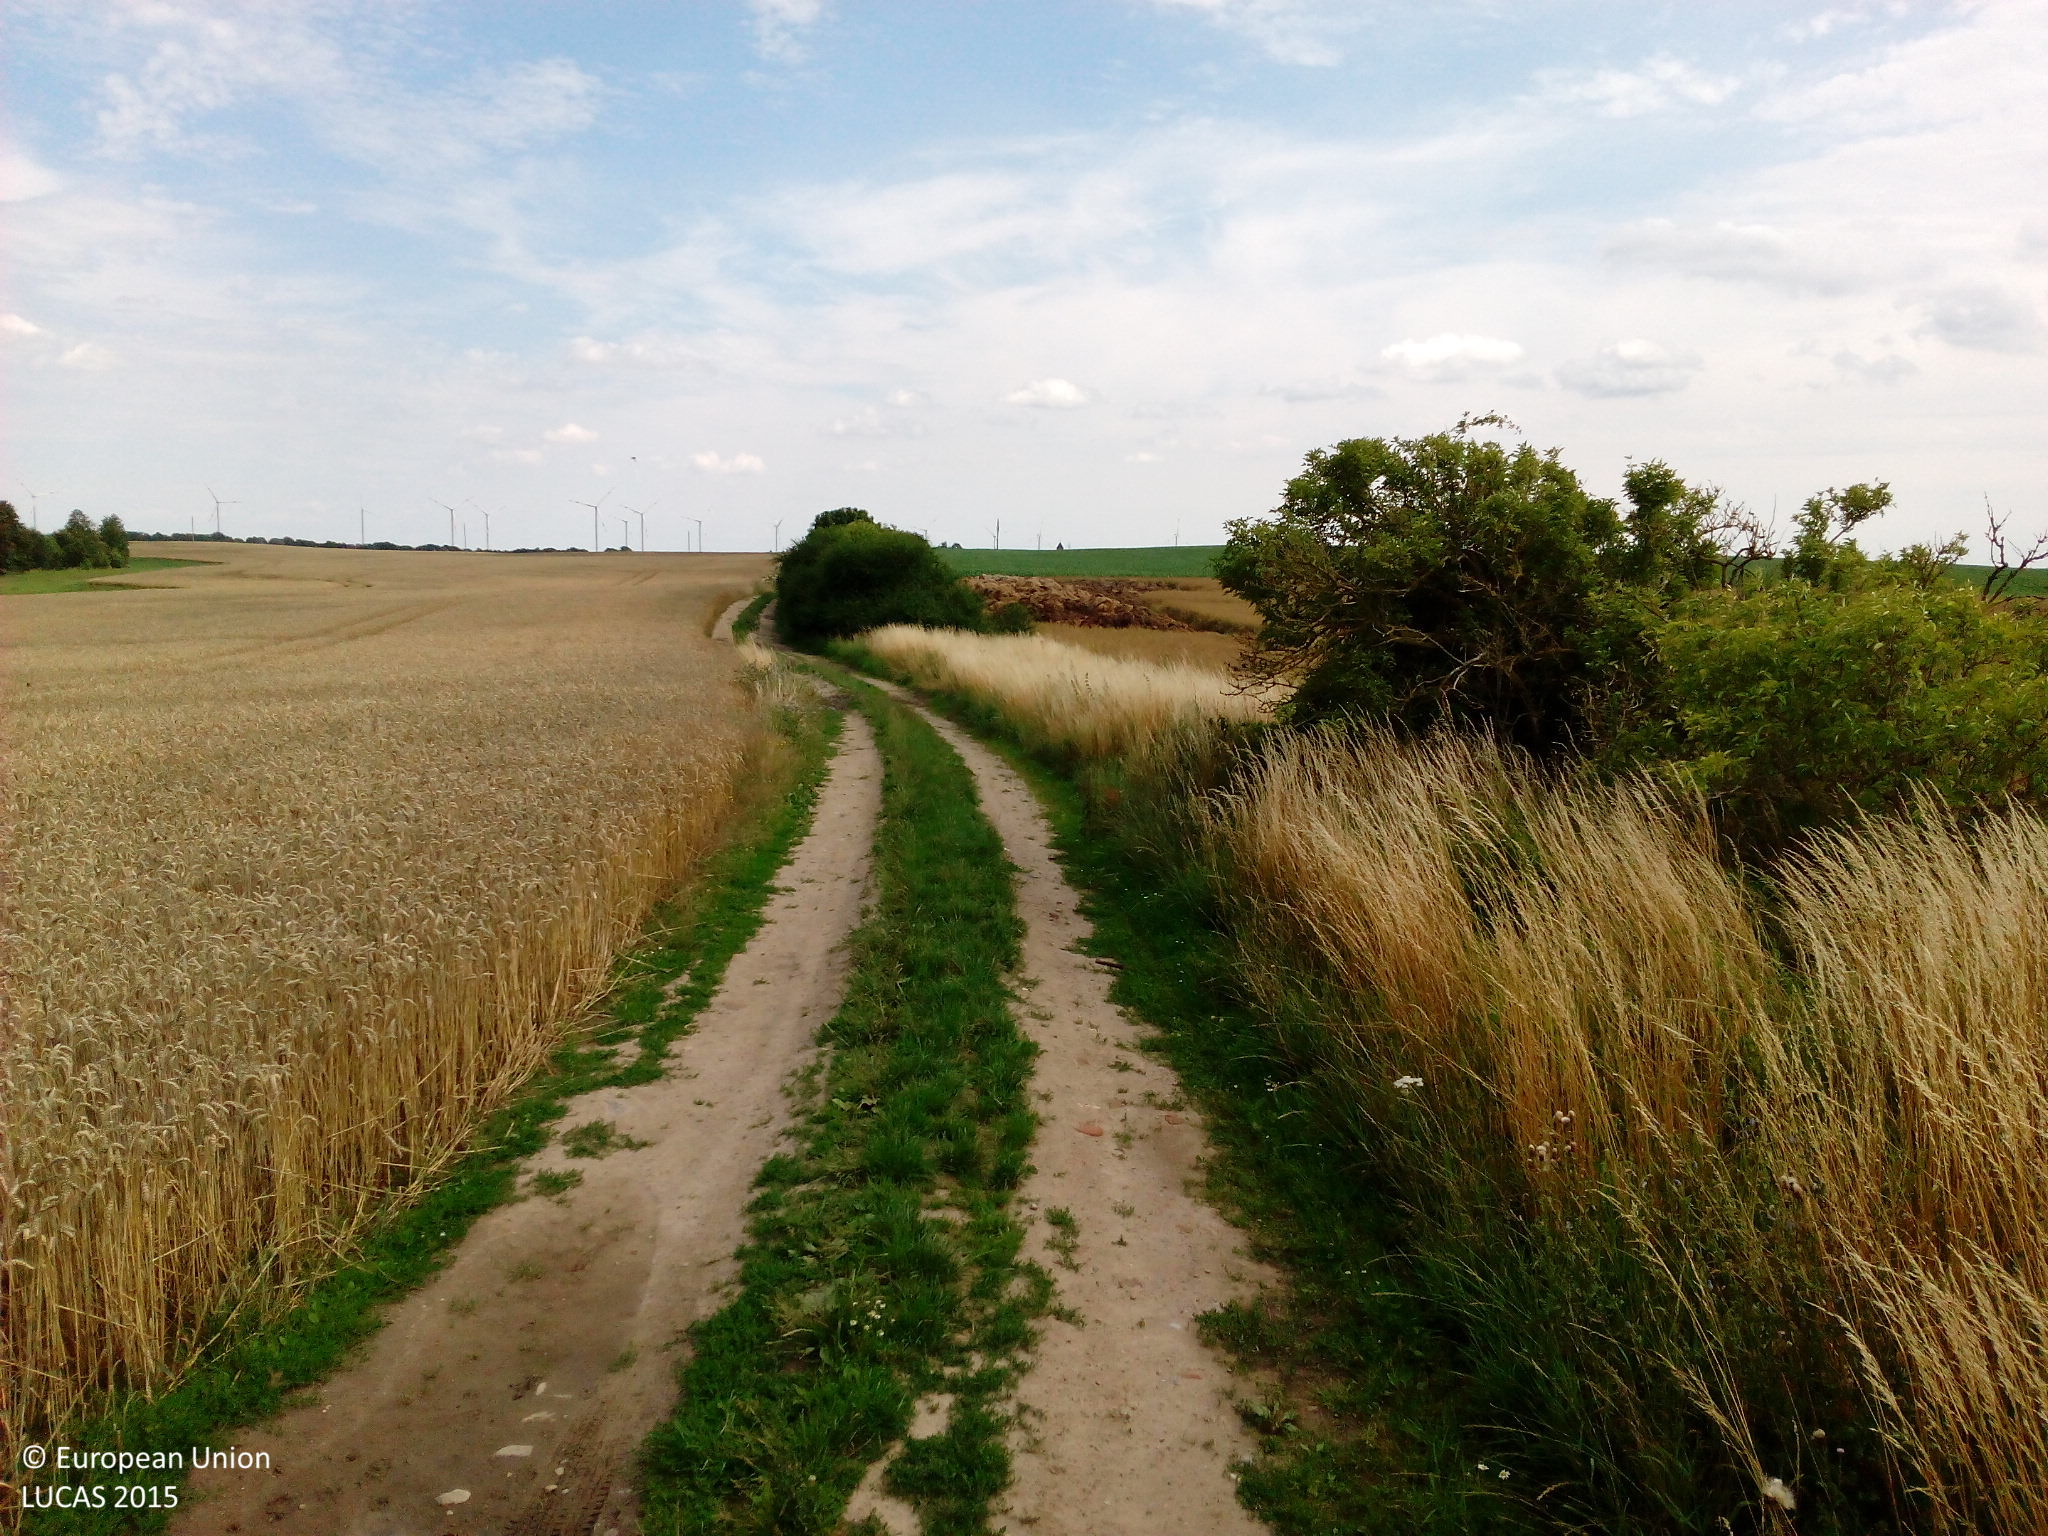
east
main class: Cropland
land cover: Rape and turnip rape
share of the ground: > 75 %
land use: Agriculture (excluding fallow land and kitchen gardens)
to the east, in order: Rape and turnip rape; Maize
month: July
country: DE
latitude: 53.4358
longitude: 13.6879
